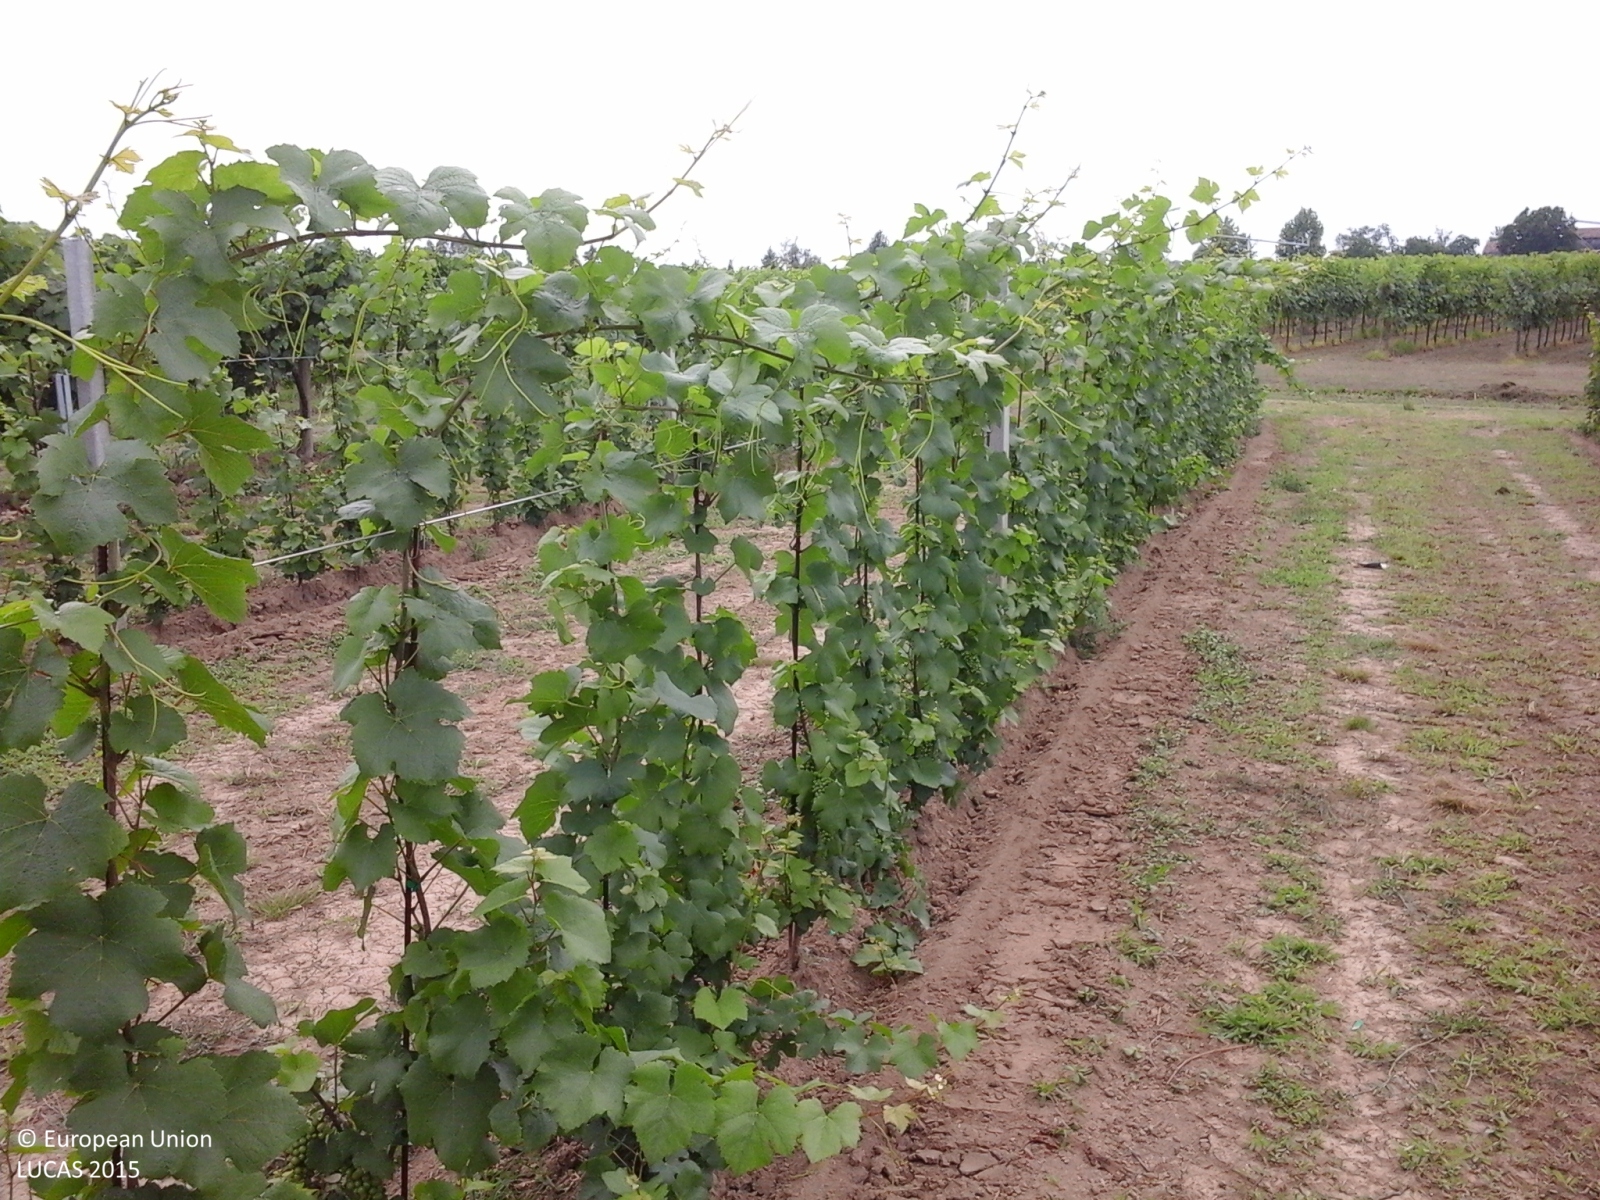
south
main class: Cropland
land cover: Vineyards
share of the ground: 50 - 75 %
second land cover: Grassland without tree/shrub cover
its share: 50 - 75 %
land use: Agriculture (excluding fallow land and kitchen gardens)
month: June
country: IT
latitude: 45.7656
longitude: 12.4011
